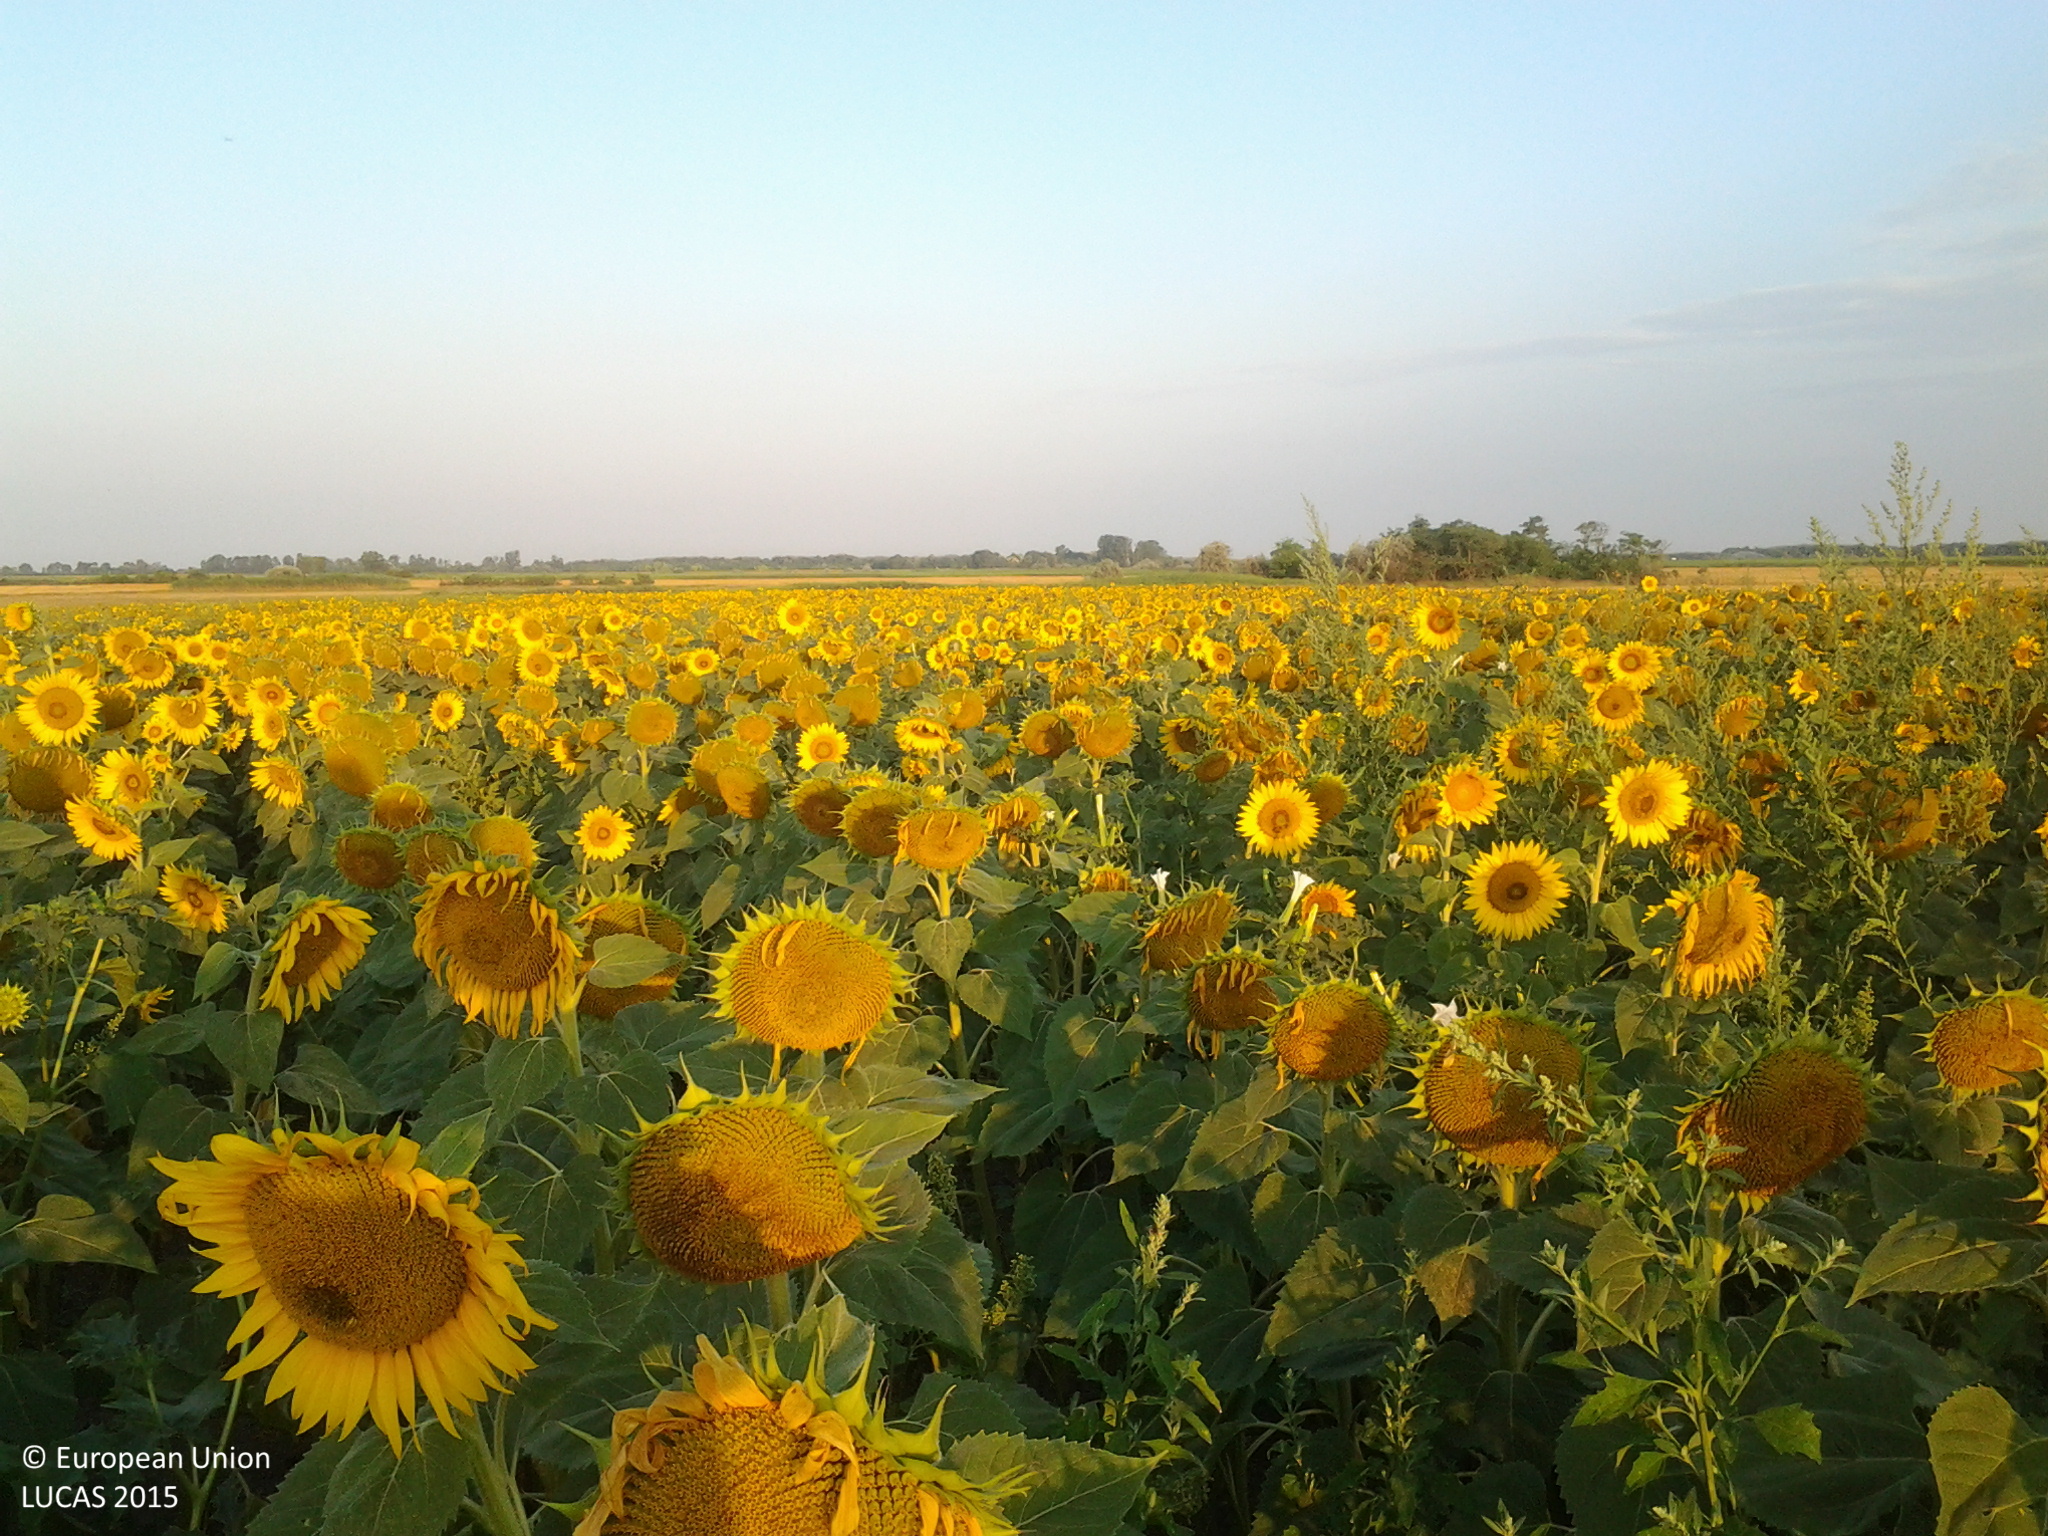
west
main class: Cropland
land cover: Sunflower
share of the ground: > 75 %
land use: Agriculture (excluding fallow land and kitchen gardens)
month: July
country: HU
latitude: 46.8813
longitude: 19.1625
